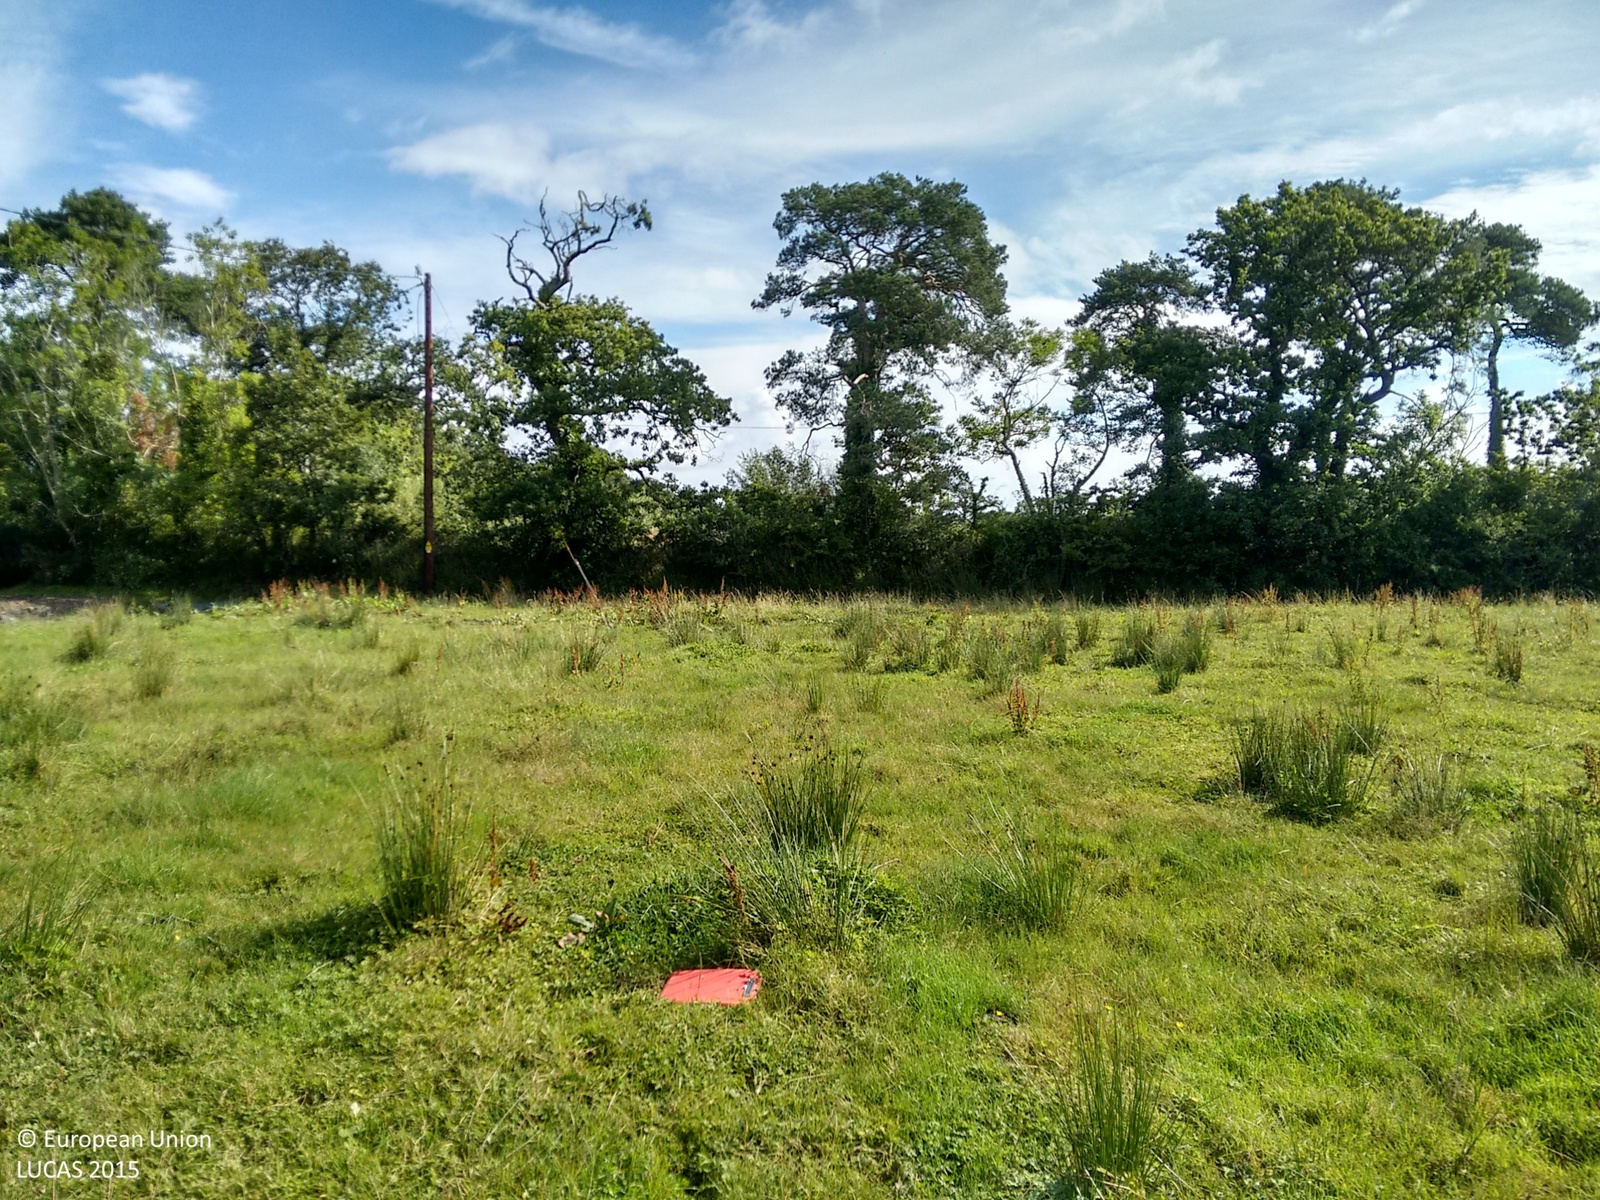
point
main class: Grassland
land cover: Grassland without tree/shrub cover
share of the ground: > 75 %
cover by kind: herbaceous plants 95 %, unconsolidated bare surface 5 %
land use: Agriculture (excluding fallow land and kitchen gardens)
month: August
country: IE
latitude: 52.7425
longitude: -6.1902
